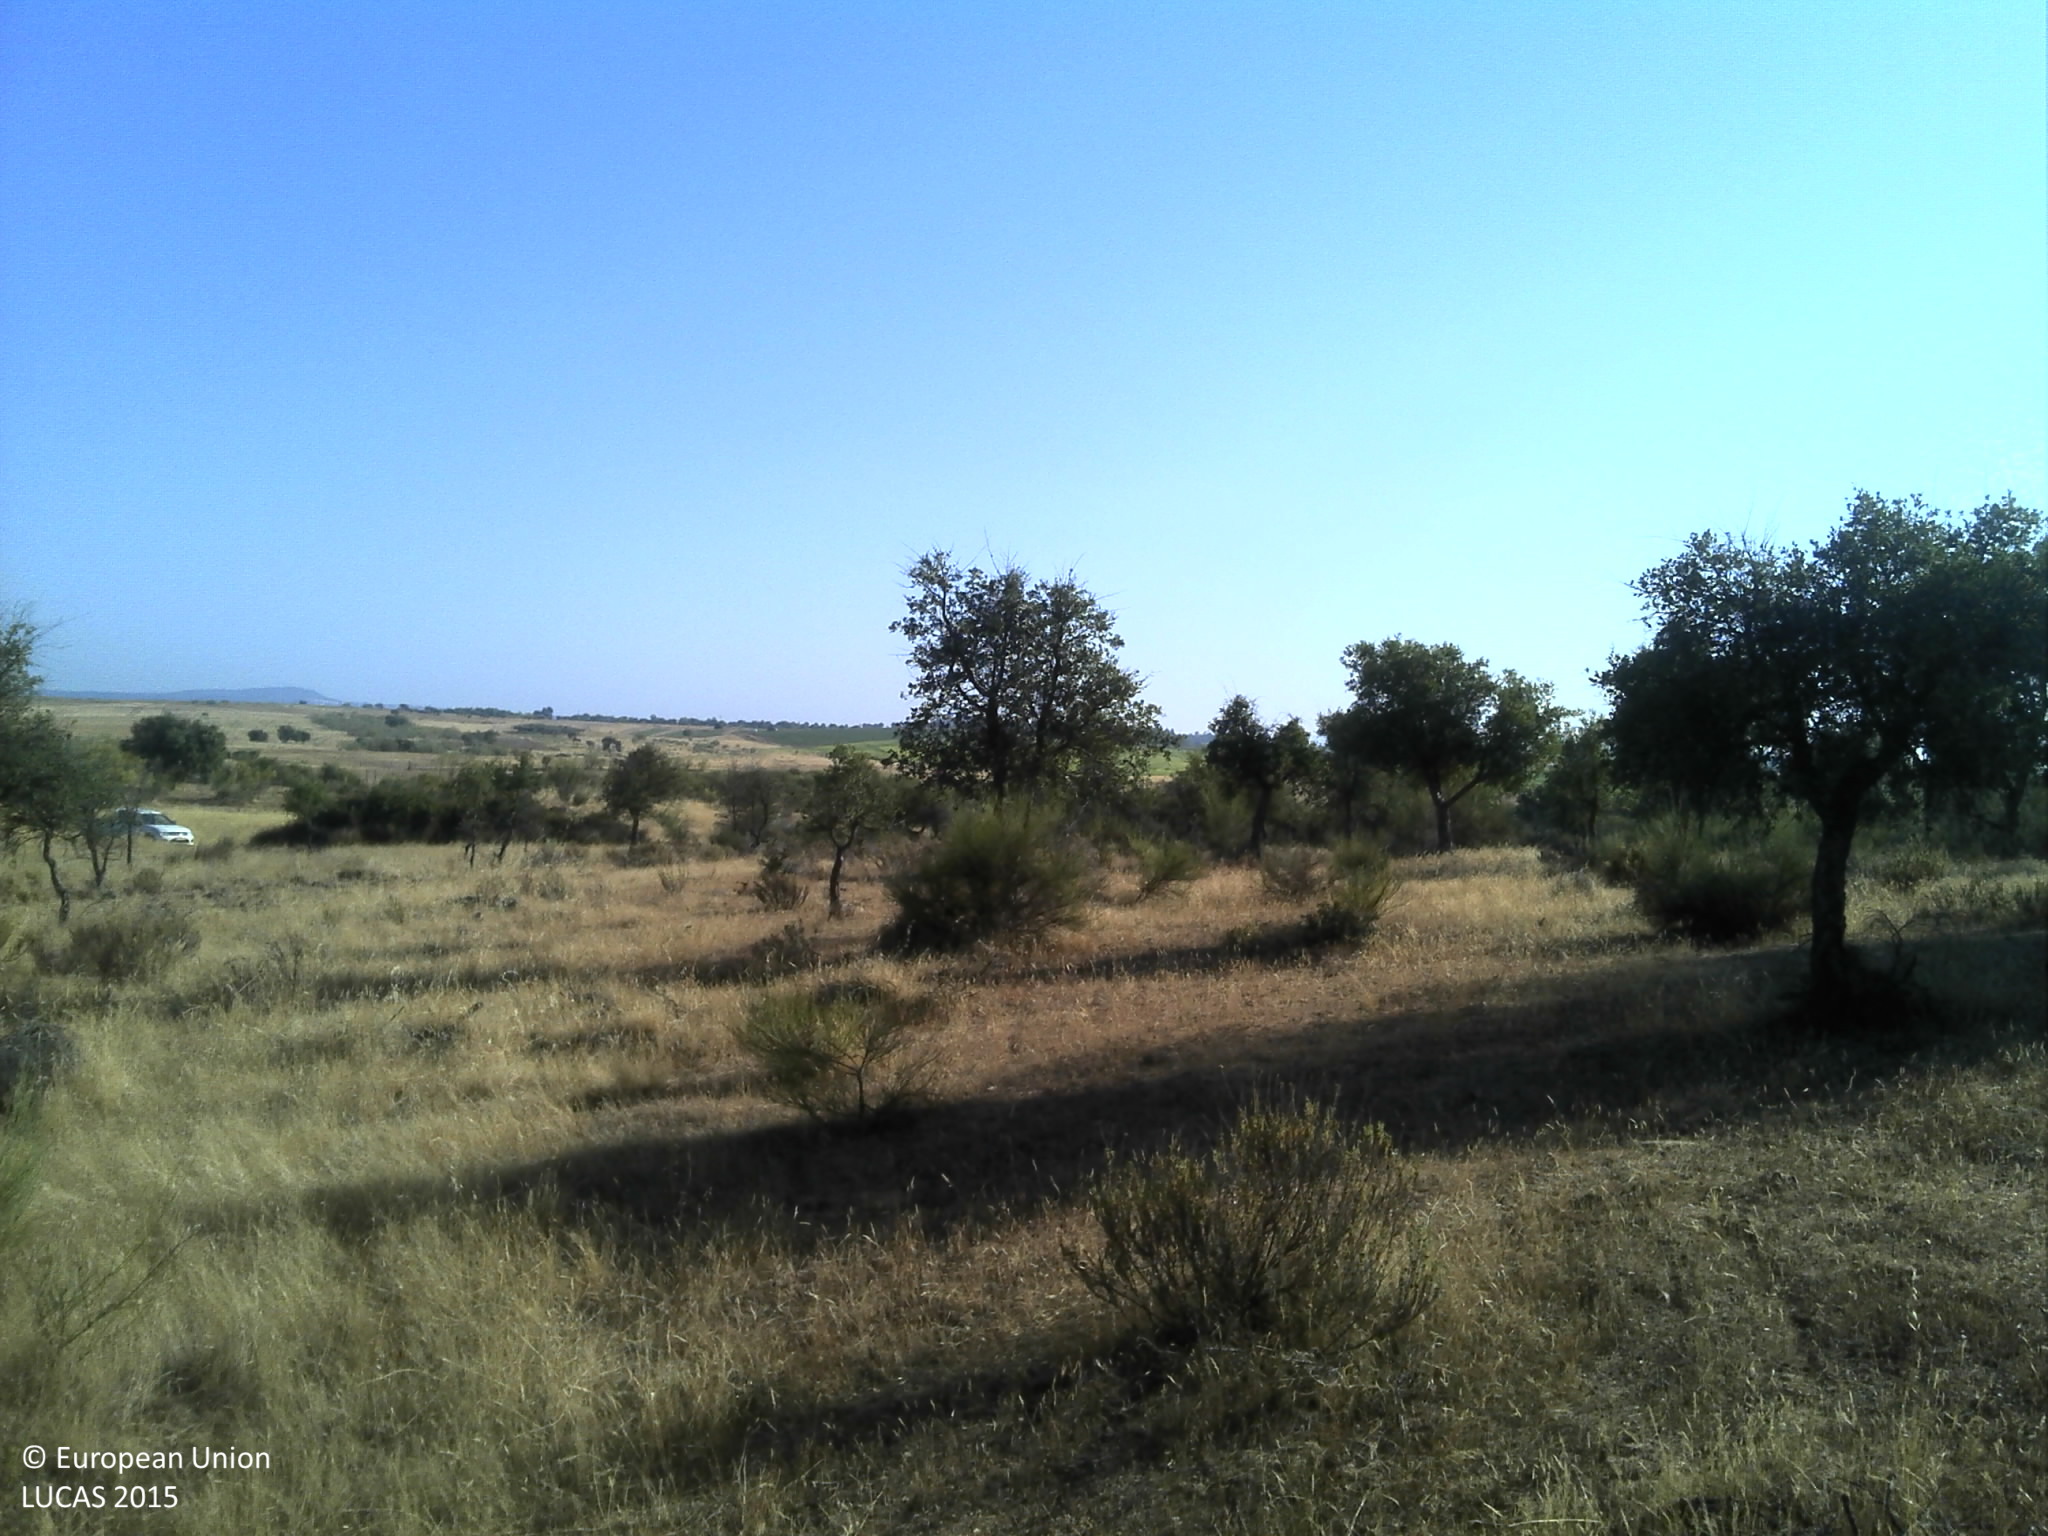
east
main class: Woodland
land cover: Broadleaved woodland
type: broadleaved evergreen forest
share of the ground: 25 - 50 %
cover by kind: broadleaved forest trees 50 %, herbaceous plants 40 %, shrubs 5 %, unconsolidated bare surface 5 %
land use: Forestry
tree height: > 5 m
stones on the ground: 10 - 25 %
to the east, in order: Broadleaved woodland; Tracks; Broadleaved woodland; Fences; Grassland without tree/shrub cover
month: June
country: PT
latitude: 39.8184
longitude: -7.2307
